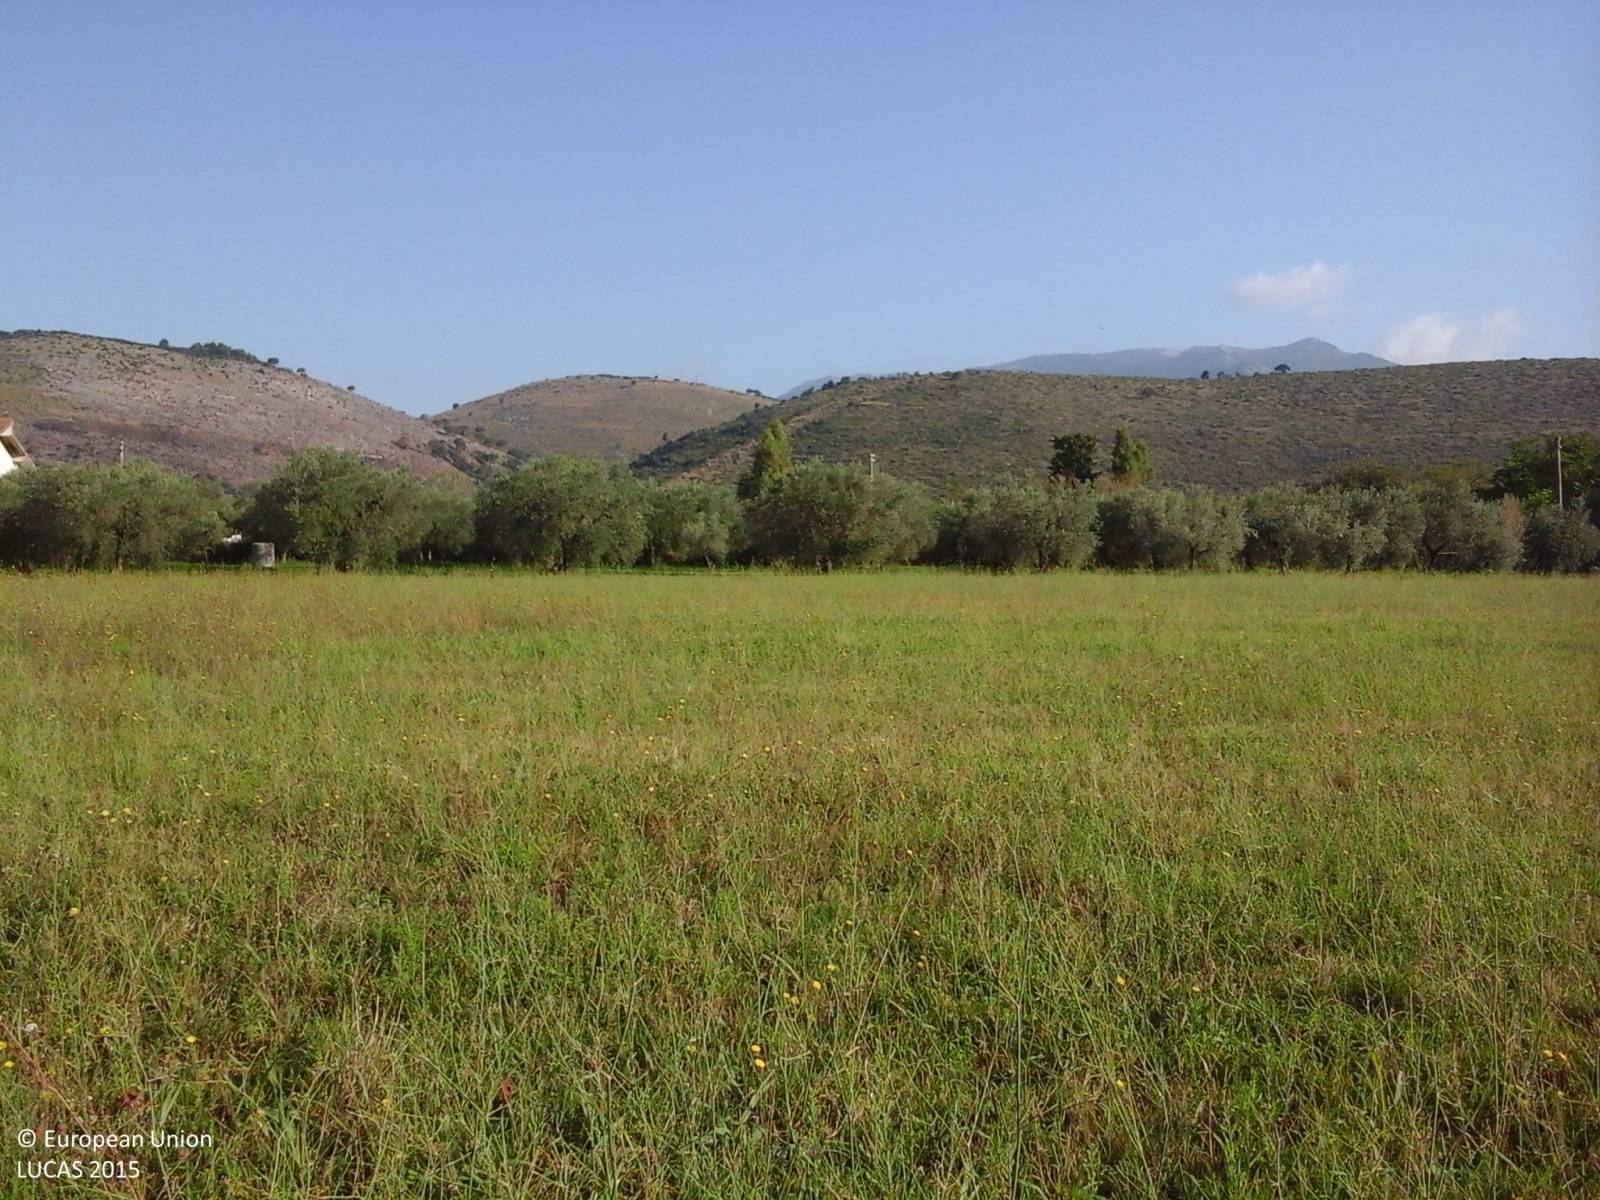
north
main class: Grassland
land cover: Spontaneously vegetated surfaces
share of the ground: > 75 %
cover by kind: herbaceous plants 100 %
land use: Agriculture (excluding fallow land and kitchen gardens)
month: August
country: IT
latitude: 41.4851
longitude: 13.1136
